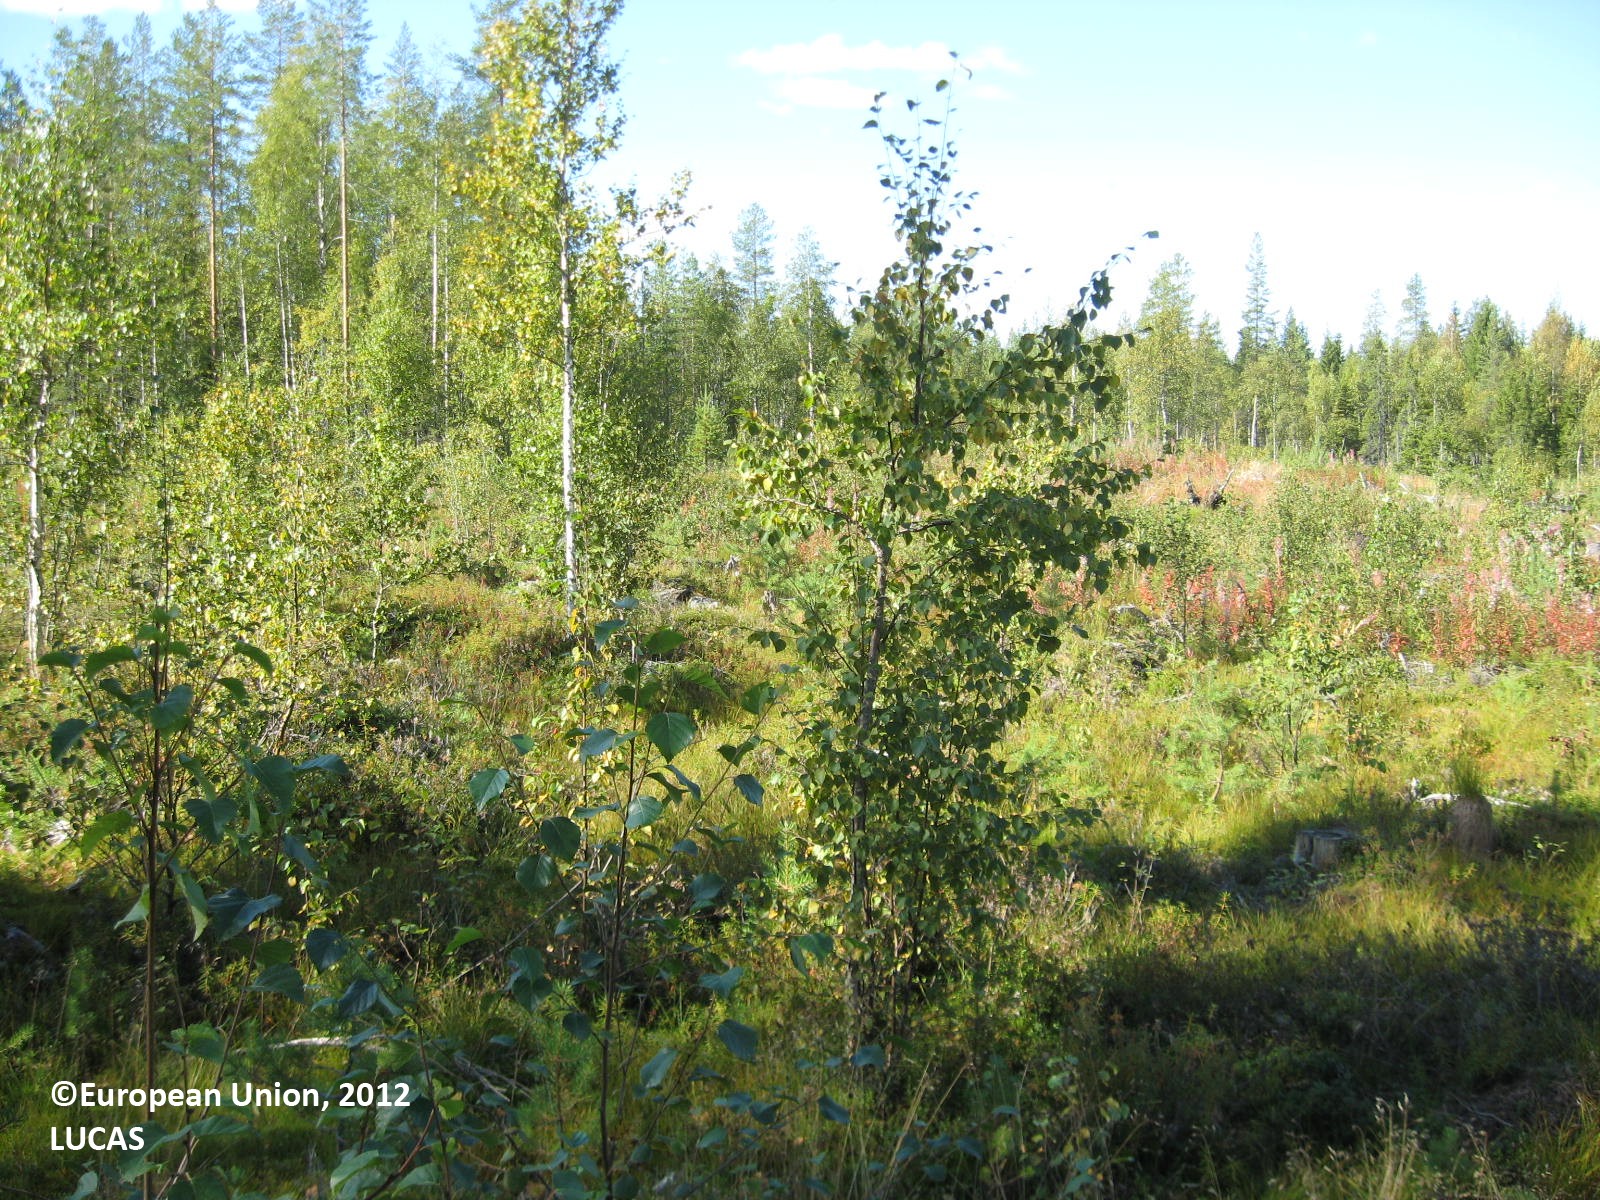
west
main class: Woodland
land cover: Other mixed woodland
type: boreal forest
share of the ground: 50 - 75 %
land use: Forestry
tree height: < 5 m
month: August
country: FI
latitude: 63.8345
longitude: 29.8514
